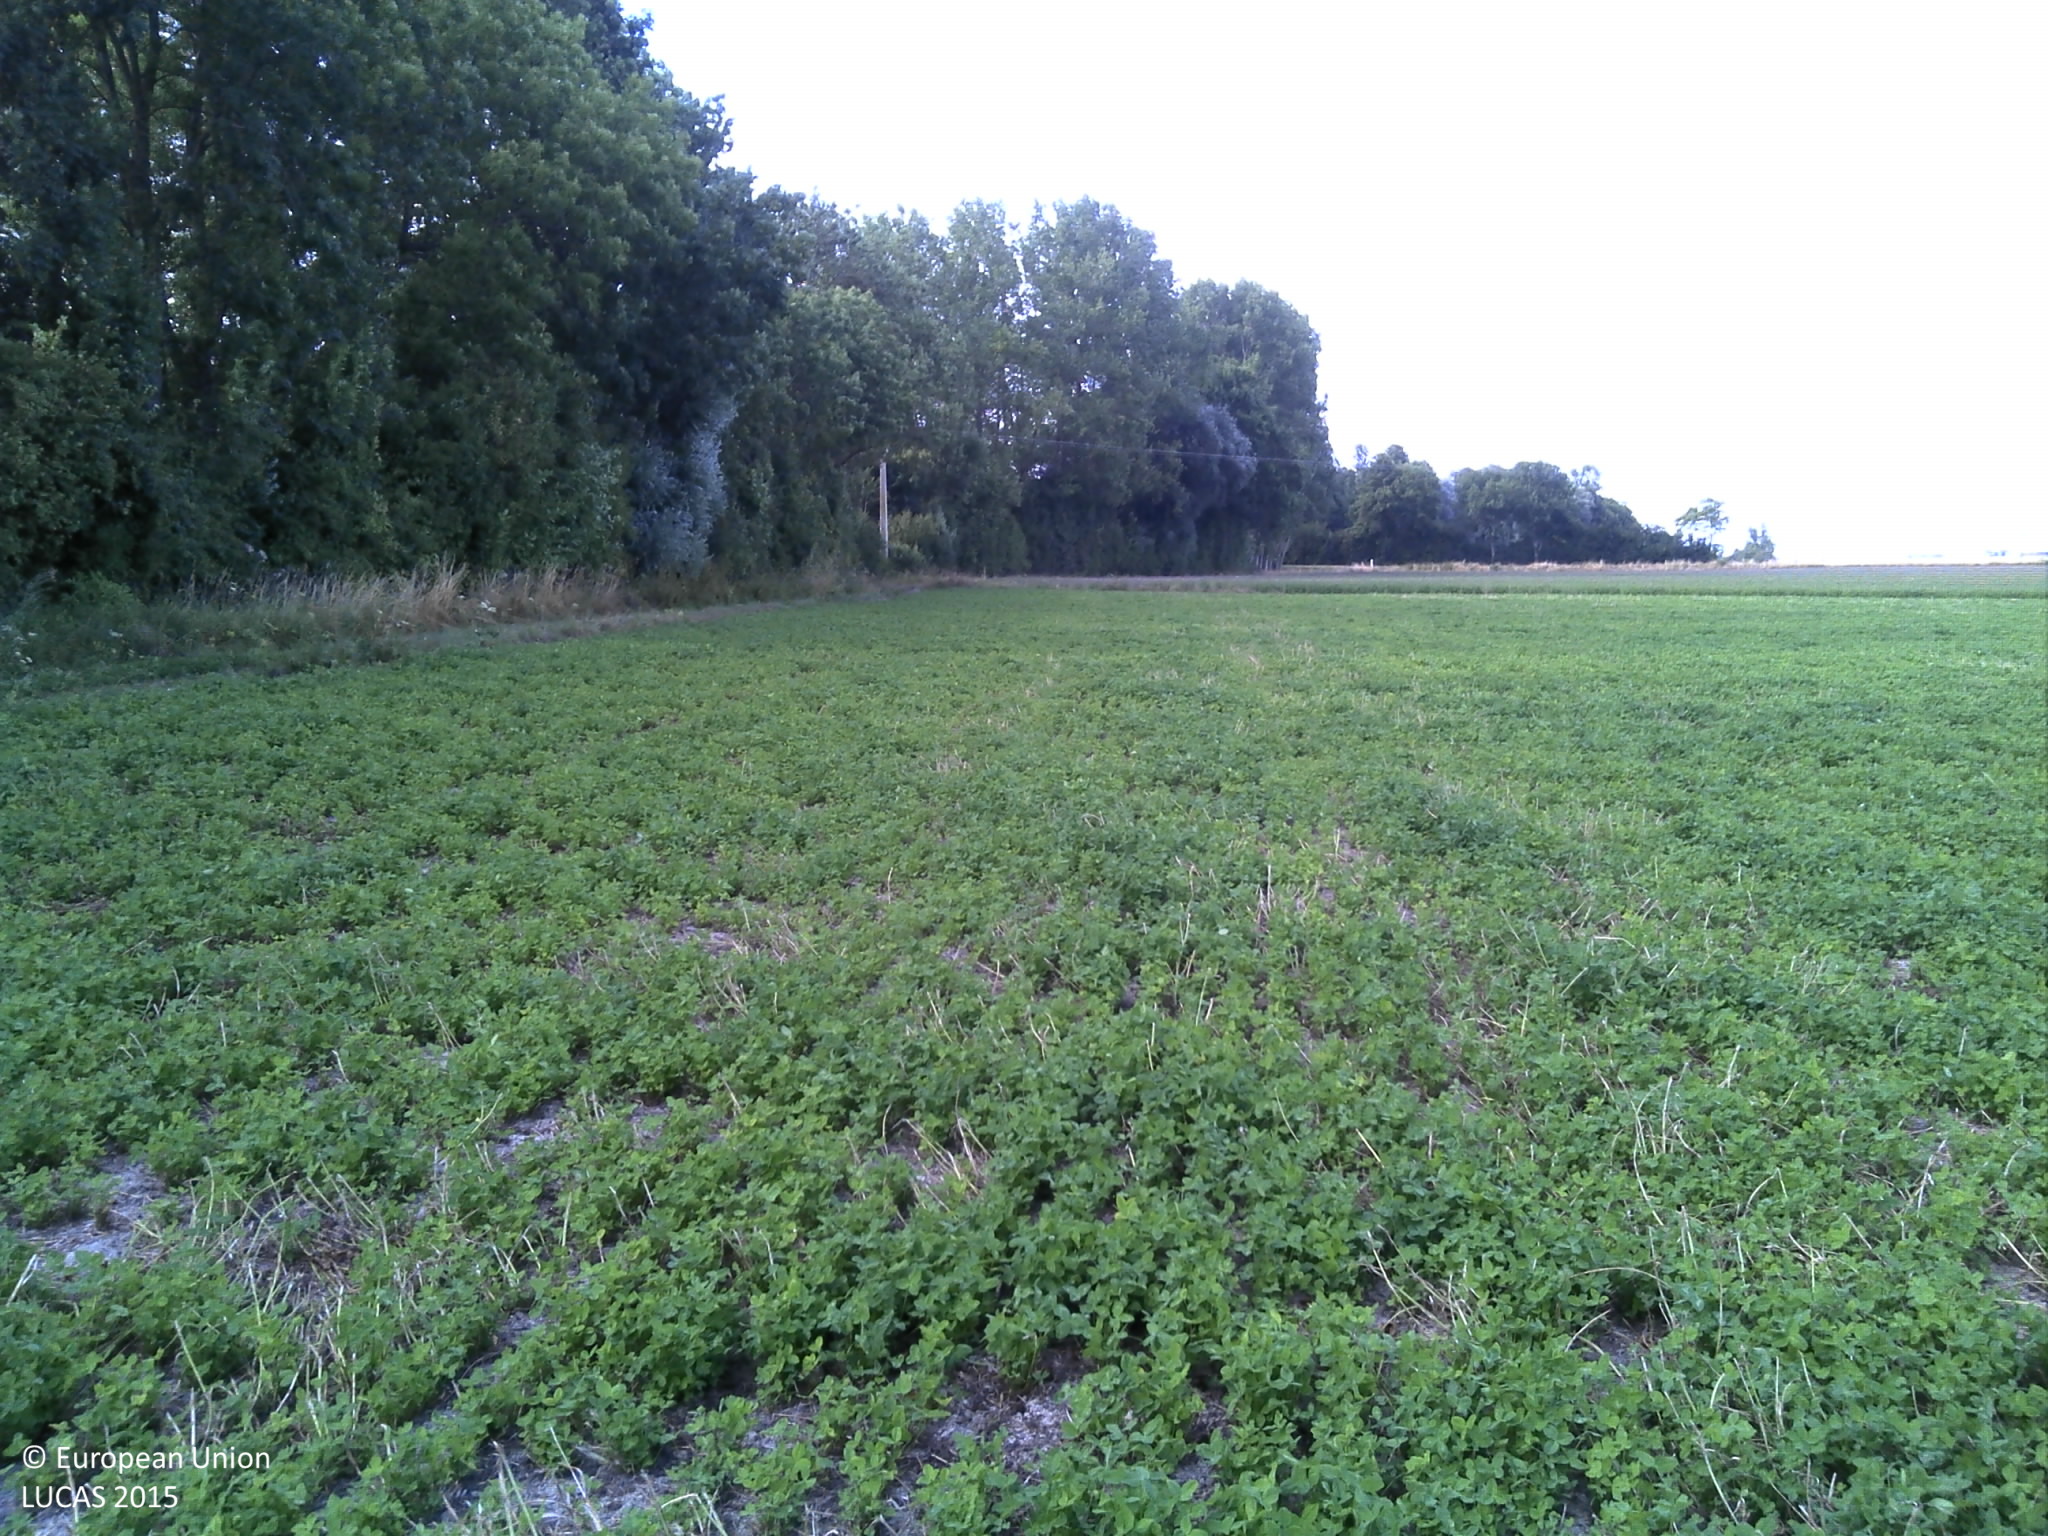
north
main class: Cropland
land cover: Clovers
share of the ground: > 75 %
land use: Agriculture (excluding fallow land and kitchen gardens)
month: August
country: FR
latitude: 48.9839
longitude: 4.7913
